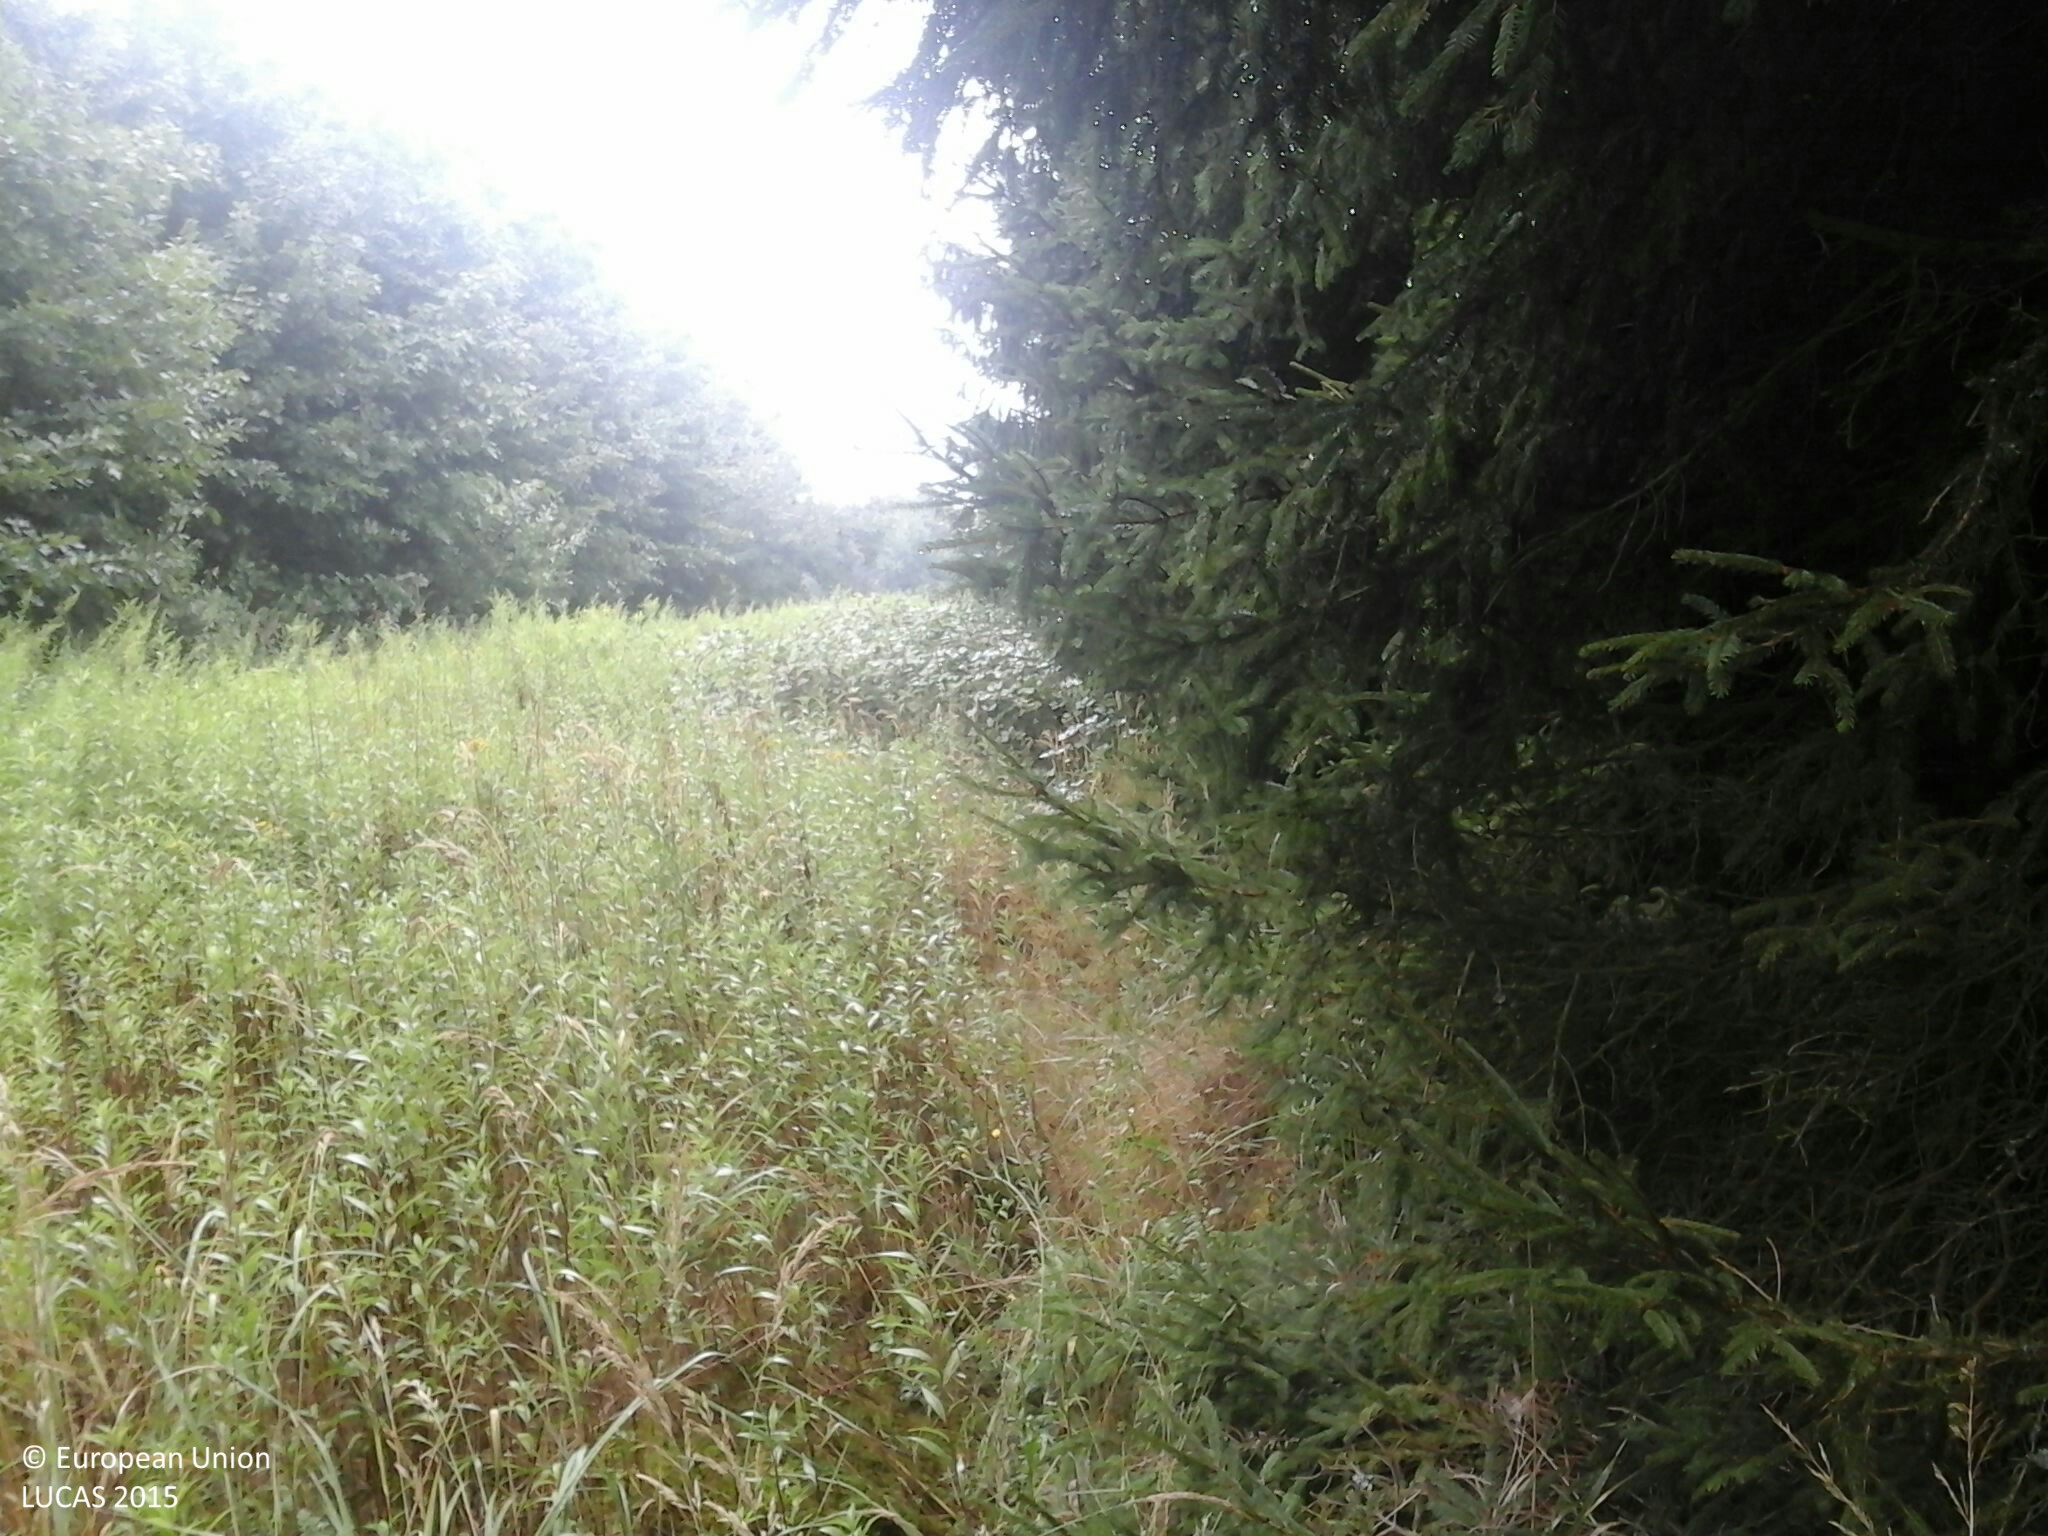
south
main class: Woodland
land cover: Spruce dominated coniferous woodland
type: hemiboreal forest and nemoral coniferous forest and mixed broadleaved-coniferous forest
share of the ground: > 75 %
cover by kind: coniferous forest trees 80 %, herbaceous plants 20 %
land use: Forestry
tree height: > 5 m
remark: Nursery
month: July
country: HU
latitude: 46.8583
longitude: 16.4948
